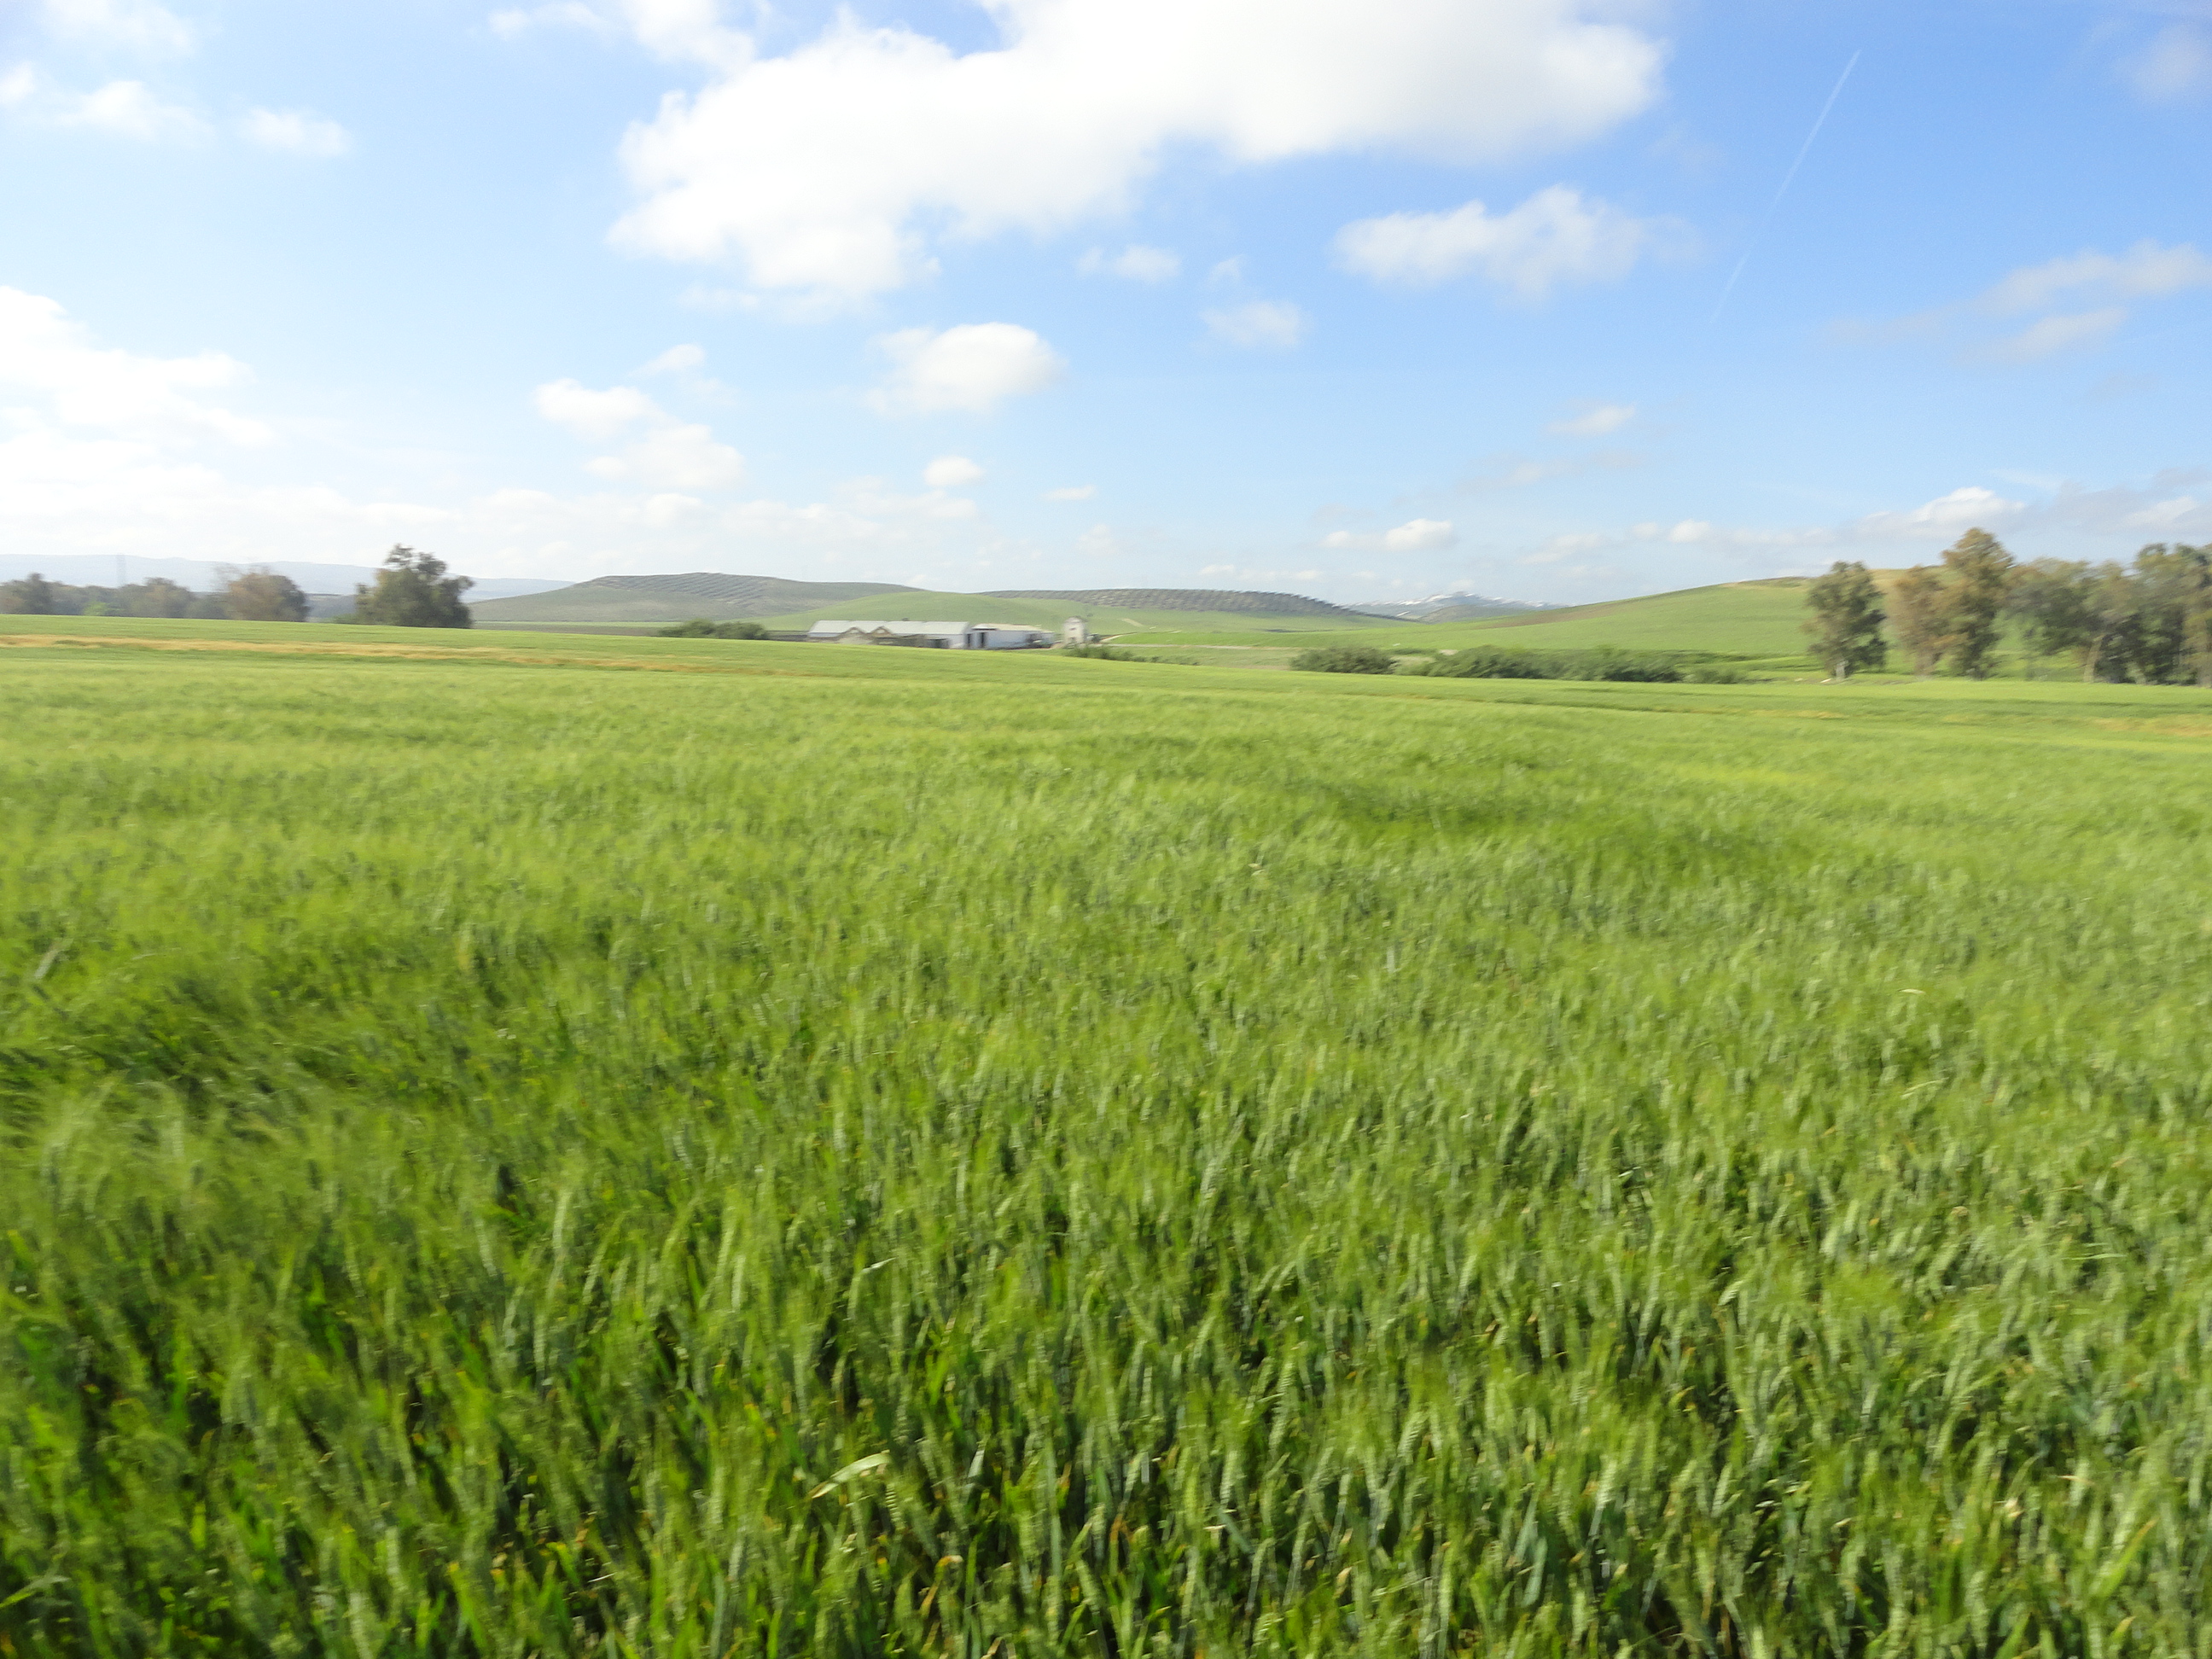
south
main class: Cropland
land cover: Durum wheat
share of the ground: > 75 %
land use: Agriculture (excluding fallow land and kitchen gardens)
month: April
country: ES
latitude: 37.6592
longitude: -4.6202
